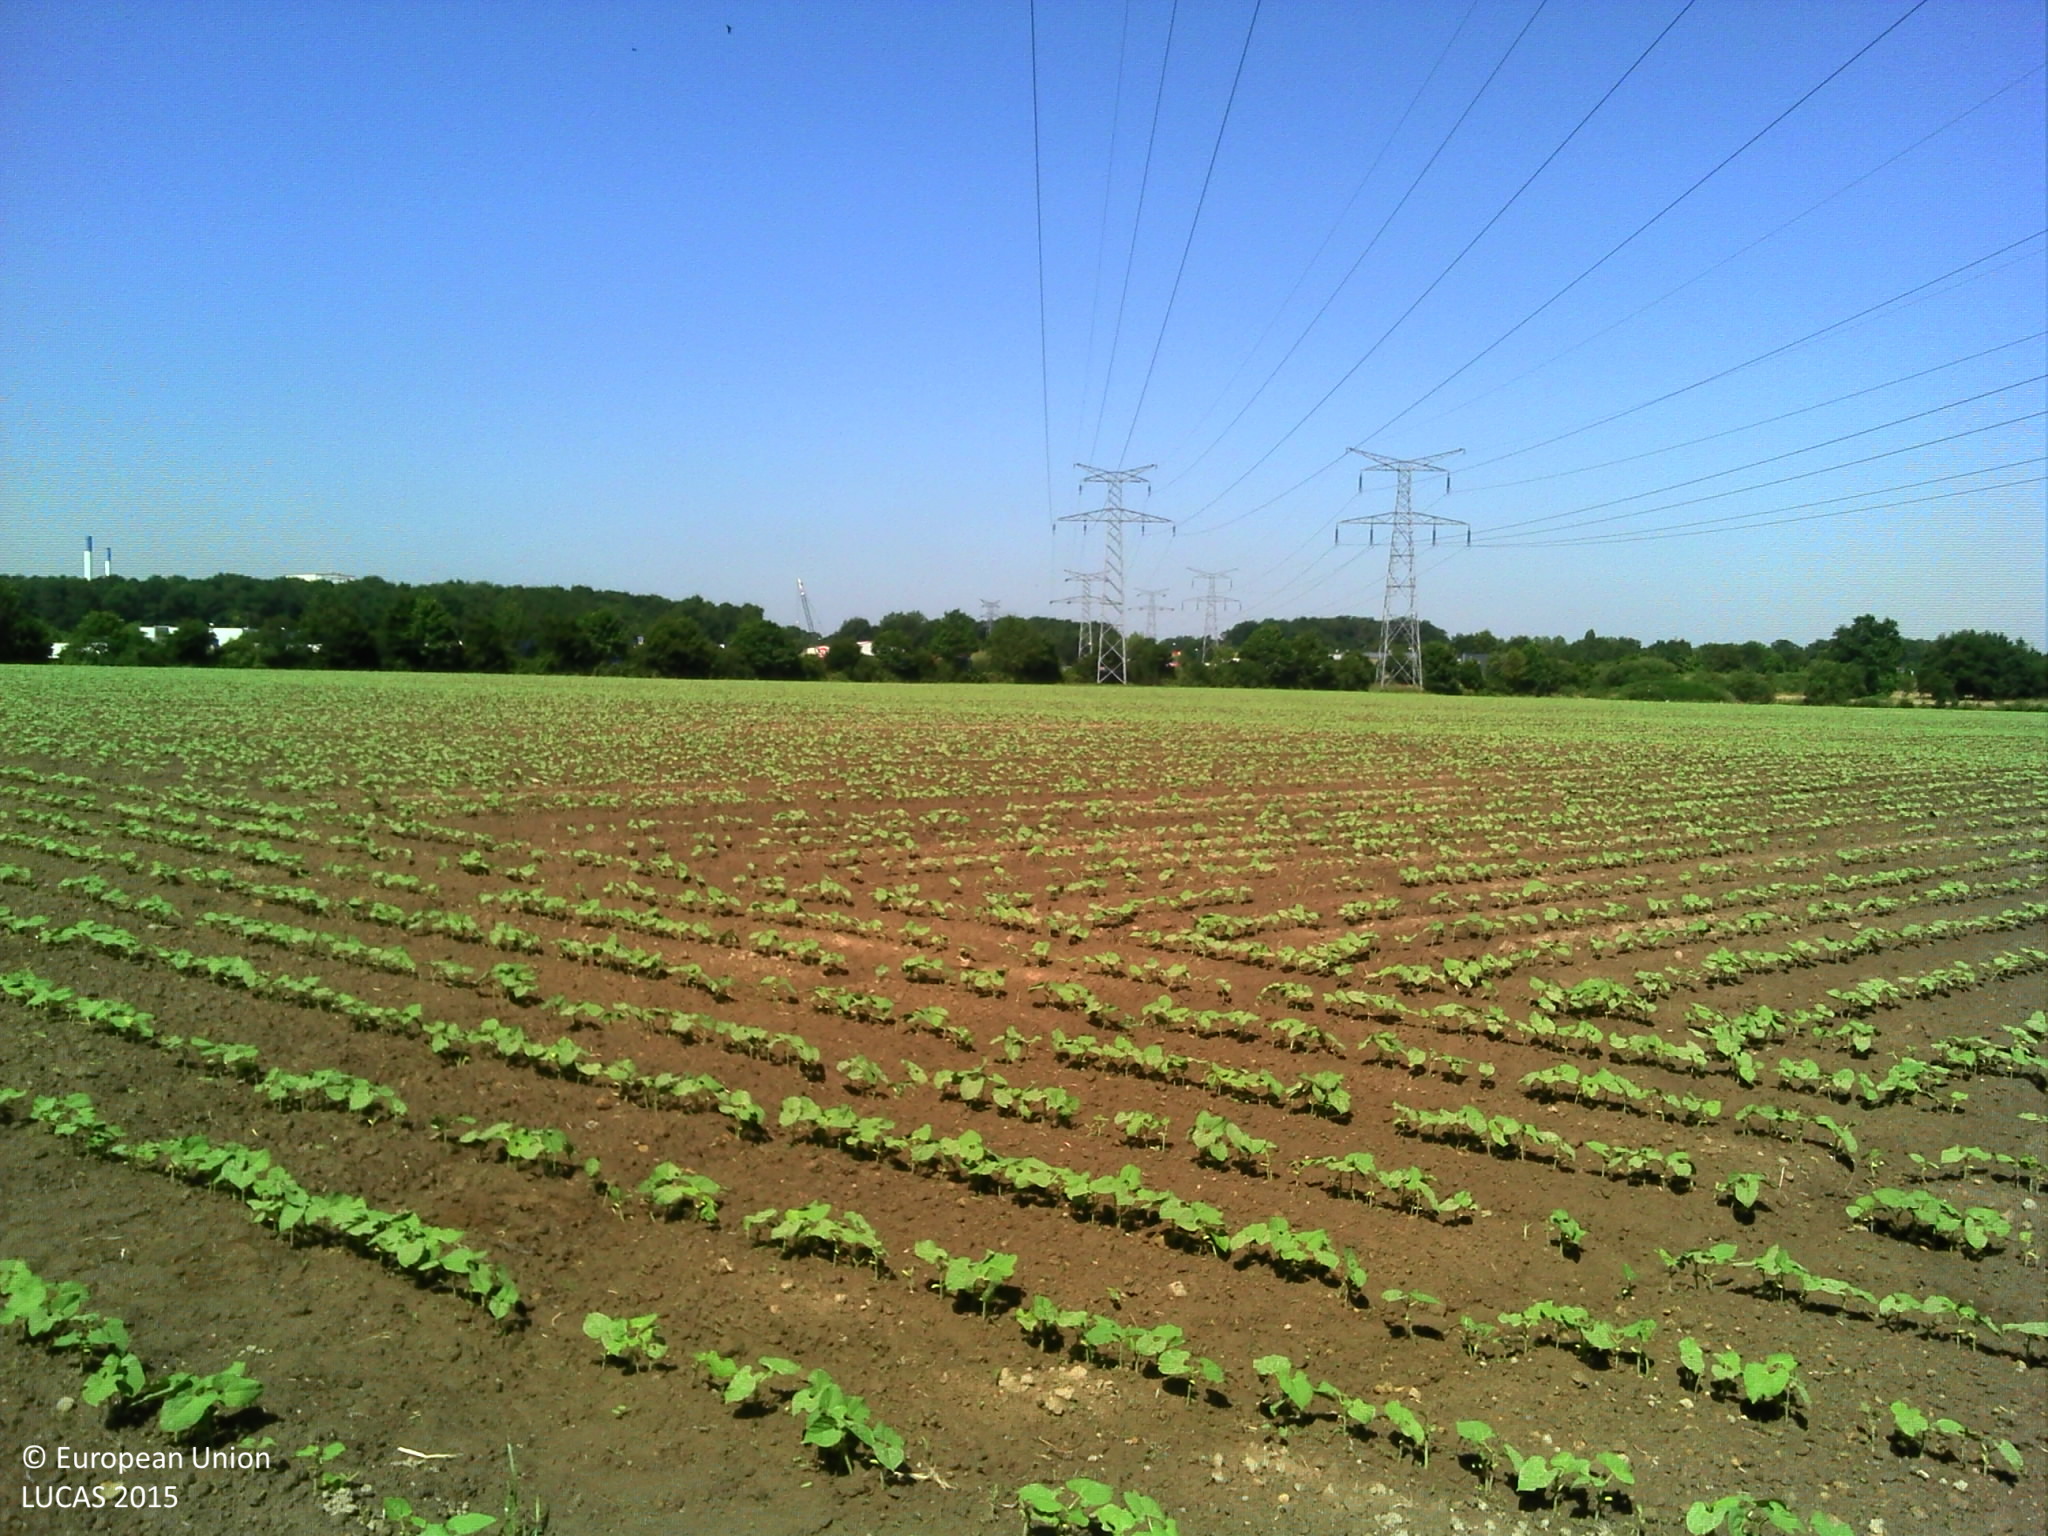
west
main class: Cropland
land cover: Dry pulses
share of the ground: 10 - 25 %
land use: Agriculture (excluding fallow land and kitchen gardens)
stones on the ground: < 10 %
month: June
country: FR
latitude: 46.7916
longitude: -1.4226
